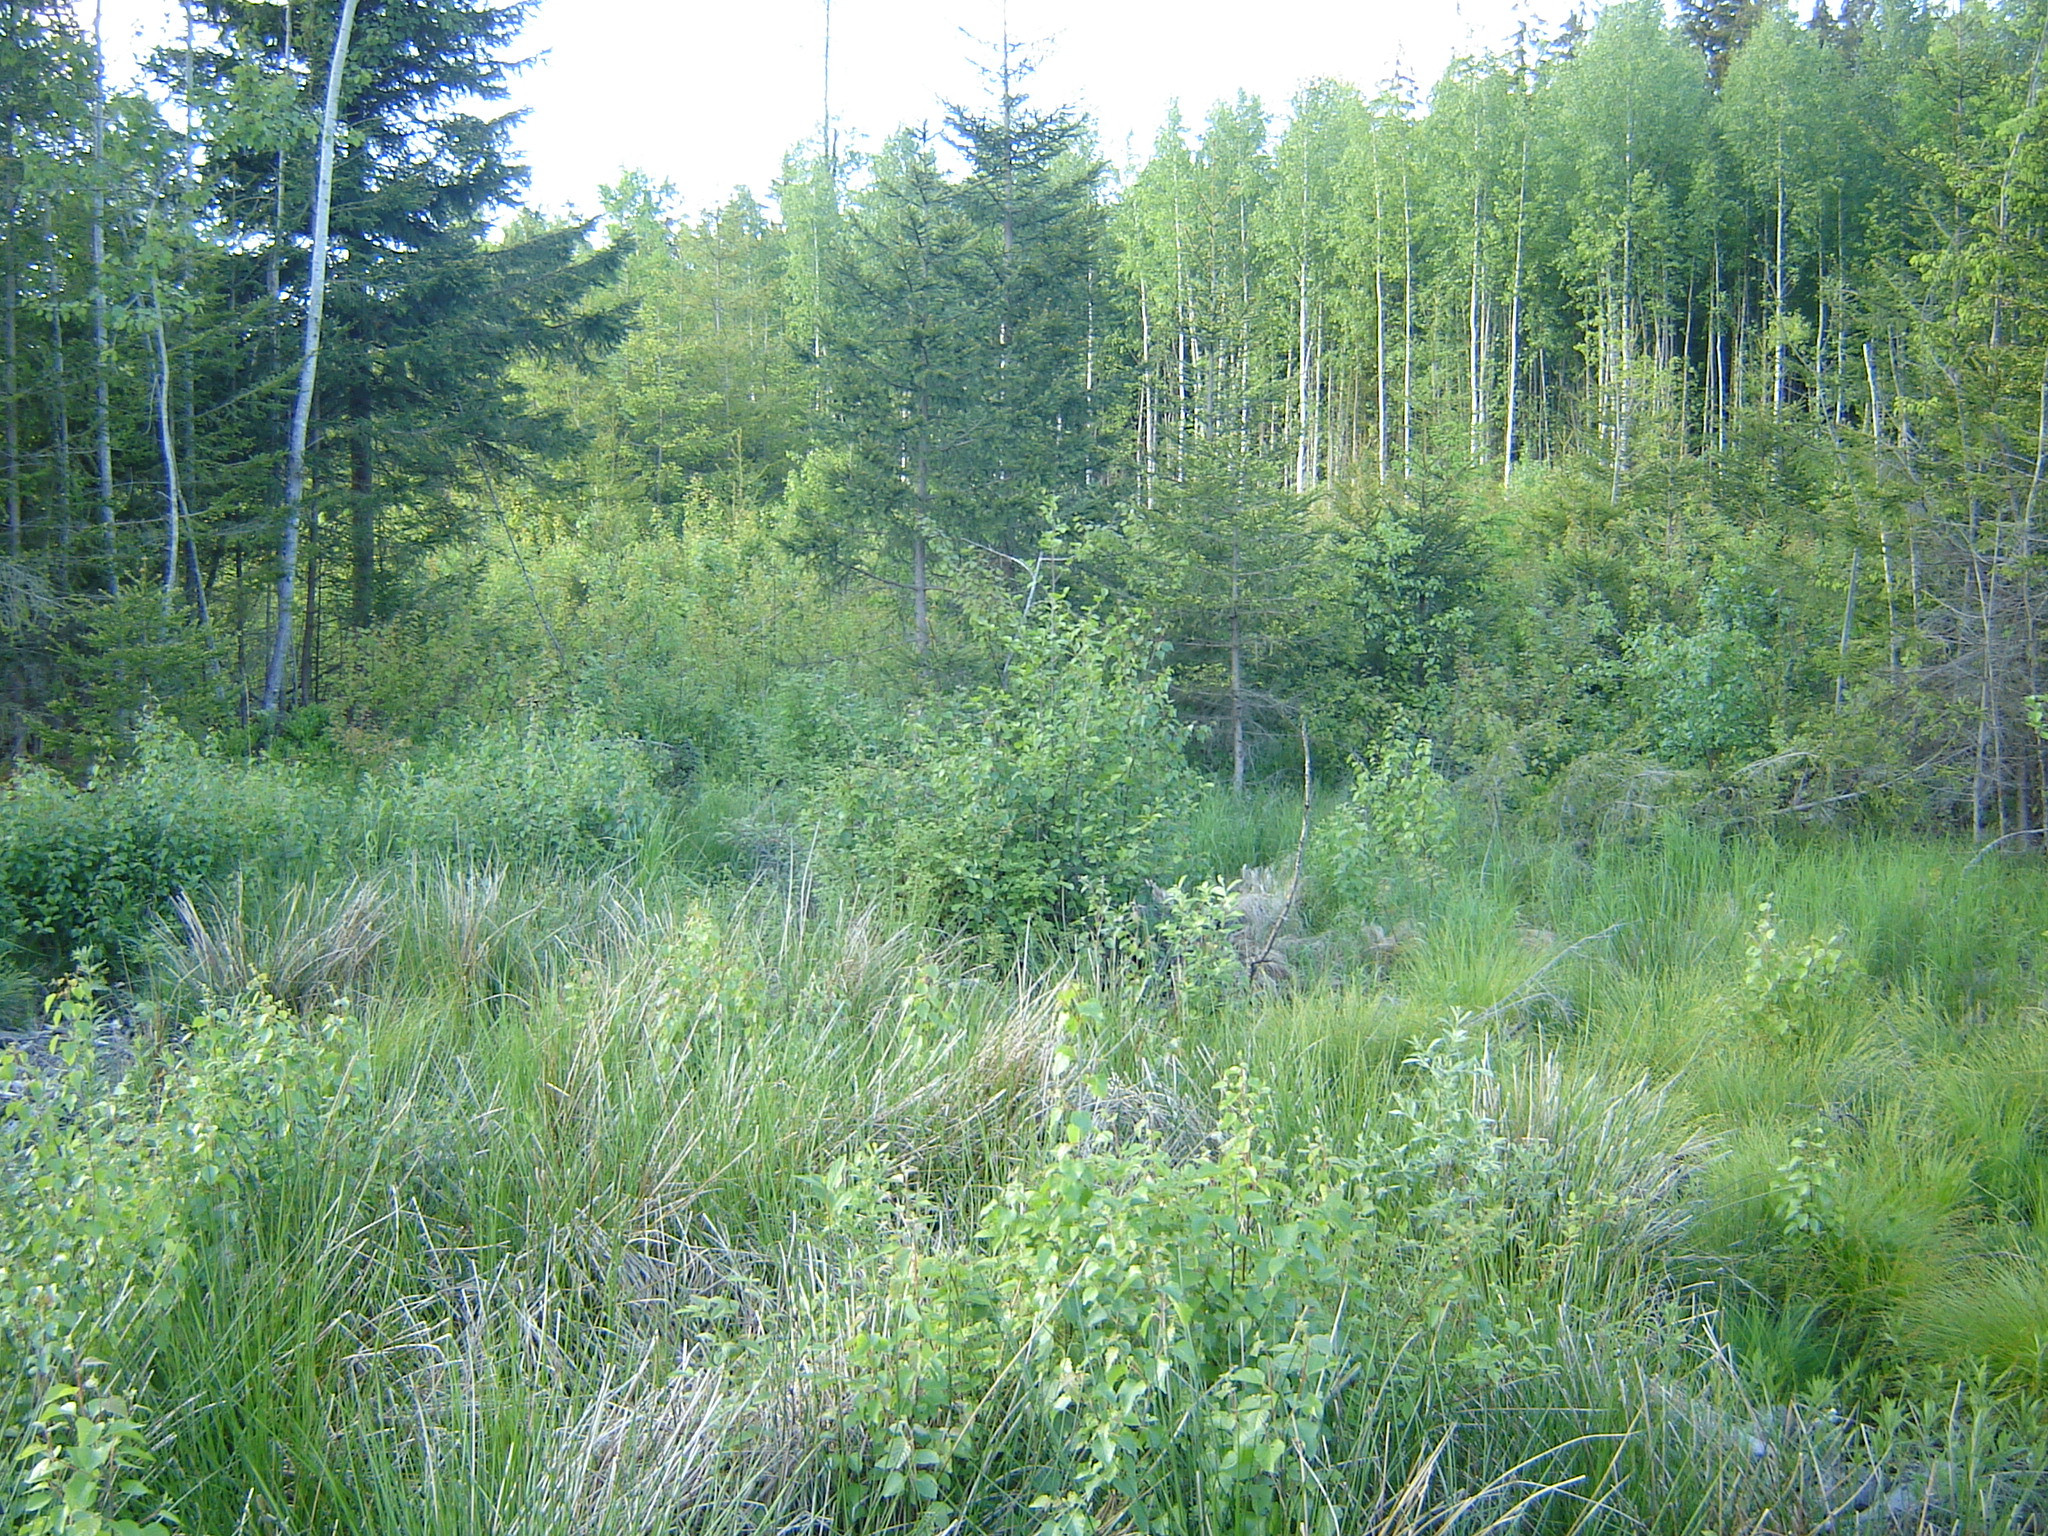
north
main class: Woodland
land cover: Spruce dominated mixed woodland
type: hemiboreal forest and nemoral coniferous forest and mixed broadleaved-coniferous forest
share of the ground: 50 - 75 %
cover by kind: broadleaved forest trees 40 %, coniferous forest trees 30 %, herbaceous plants 30 %
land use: Forestry
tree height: < 5 m
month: May
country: LT
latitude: 55.7583
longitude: 25.1413
